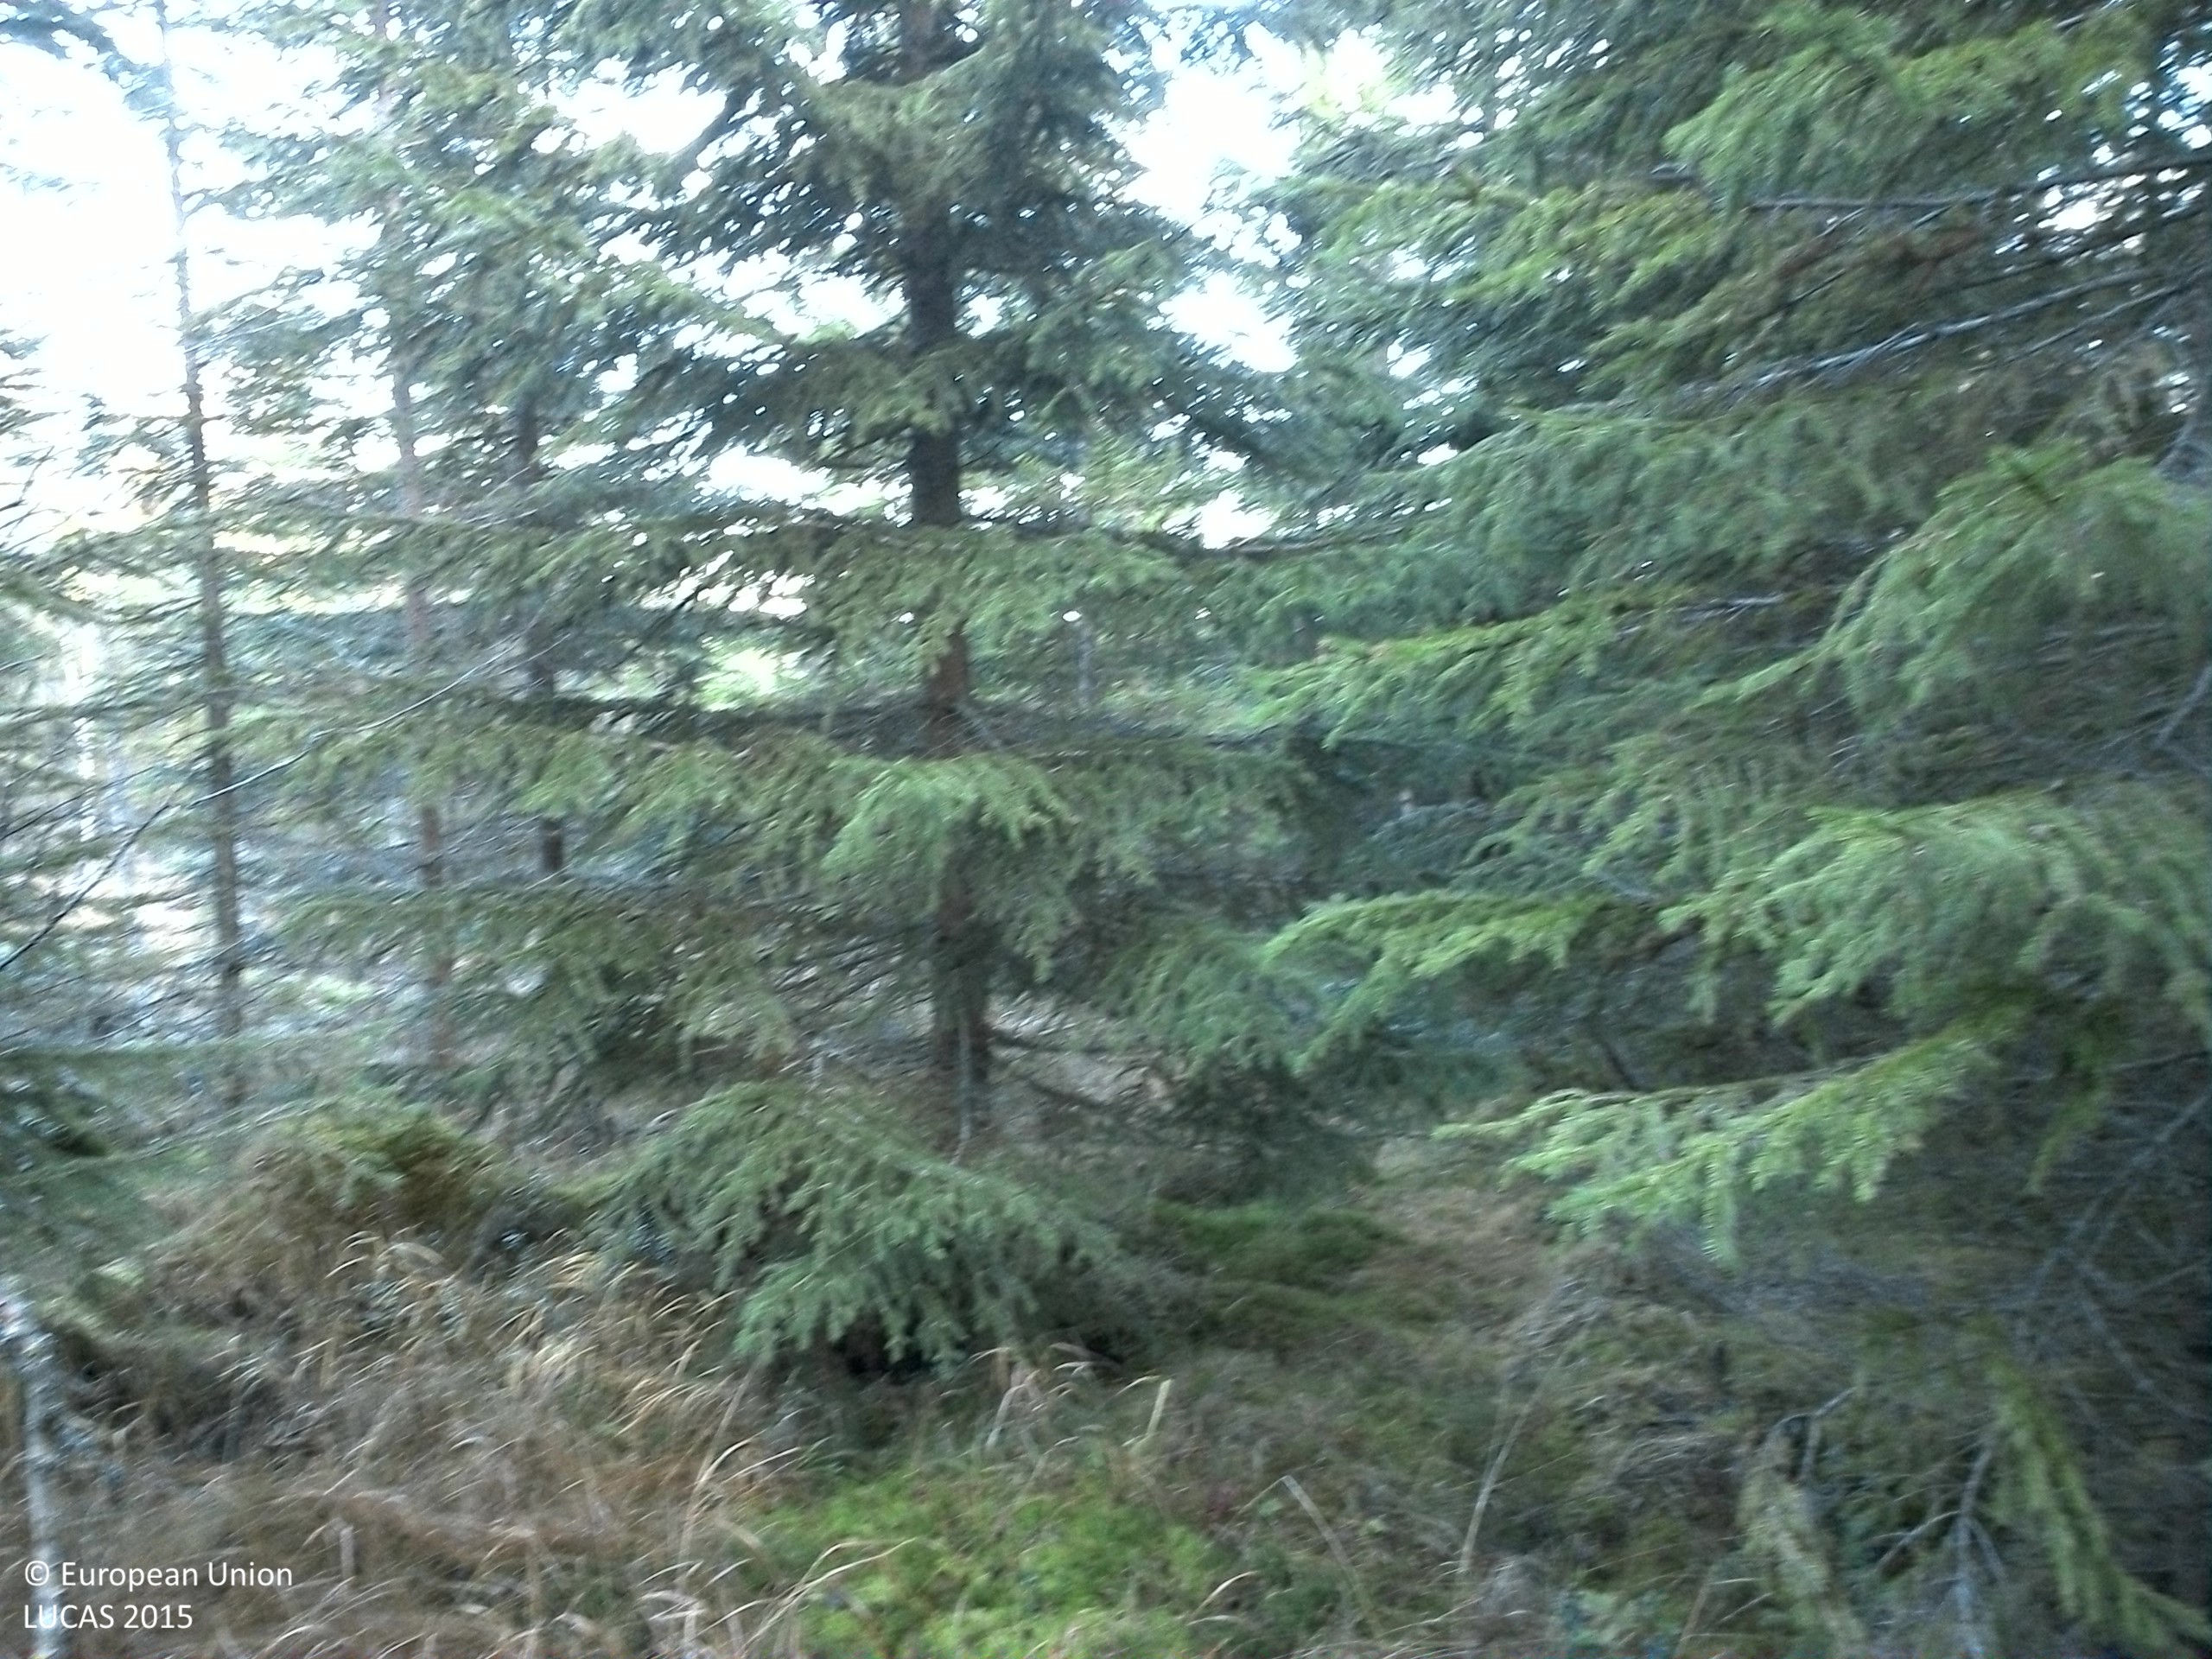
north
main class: Woodland
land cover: Spruce dominated coniferous woodland
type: boreal forest
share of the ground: 50 - 75 %
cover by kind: coniferous forest trees 70 %, herbaceous plants 10 %, lichens and mosses 10 %, broadleaved forest trees 5 %, shrubs 5 %
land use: Forestry
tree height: > 5 m
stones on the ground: < 10 %
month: November
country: SE
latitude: 60.3110
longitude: 14.9298
